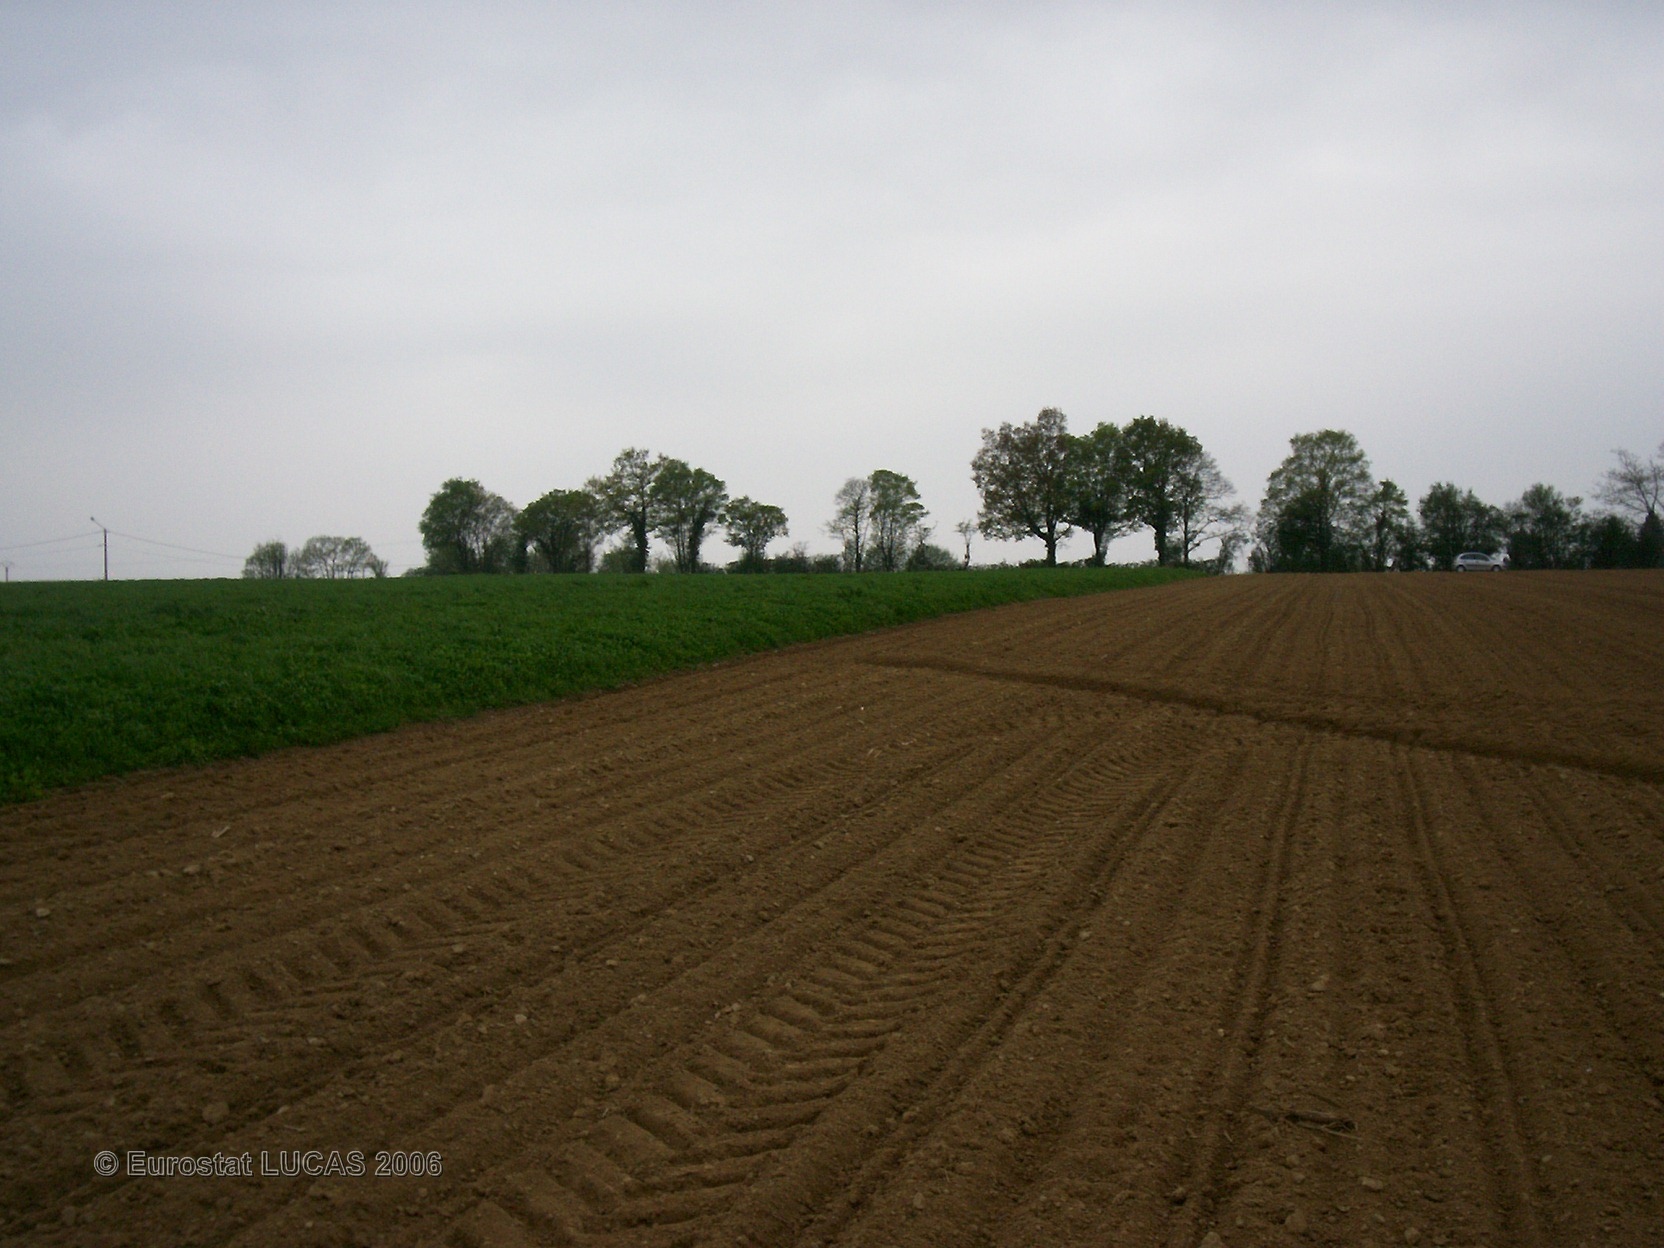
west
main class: Cropland
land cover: Maize
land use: Agriculture (excluding fallow land and kitchen gardens)
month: April
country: FR
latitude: 46.1196
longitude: 4.8654
